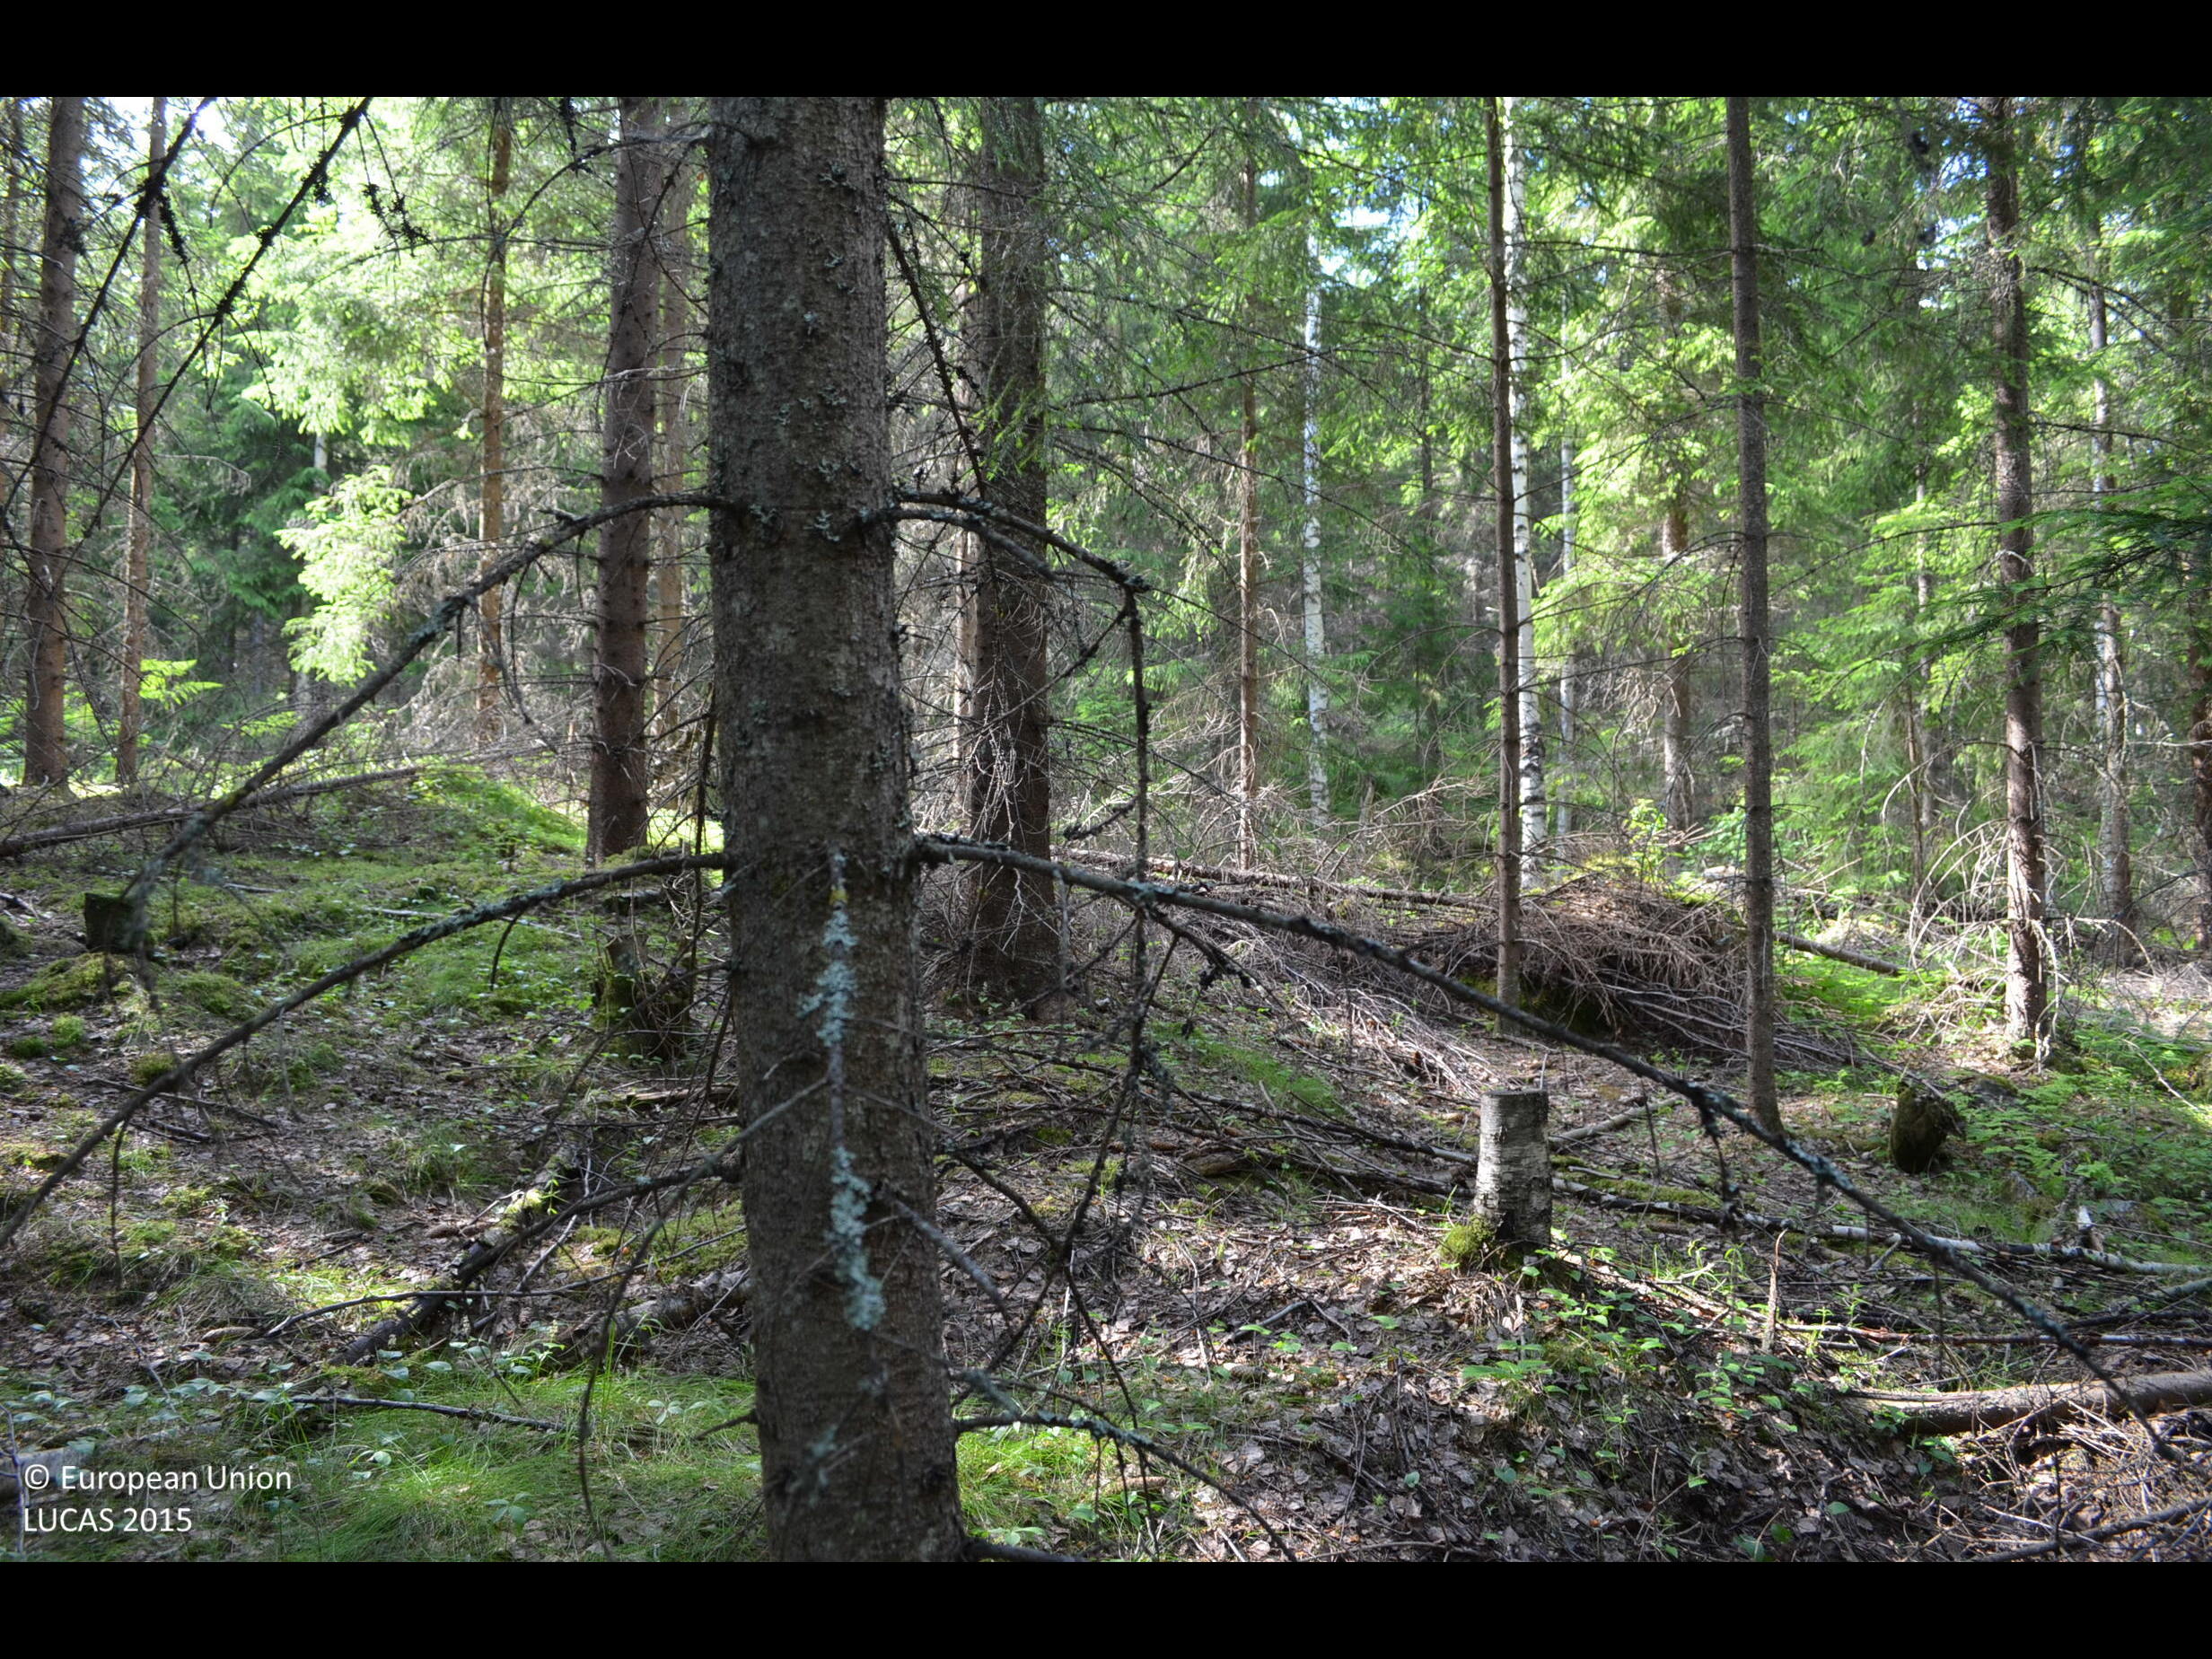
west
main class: Woodland
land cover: Spruce dominated mixed woodland
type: boreal forest
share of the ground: > 75 %
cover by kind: coniferous forest trees 55 %, broadleaved forest trees 20 %, shrubs 10 %, herbaceous plants 5 %, lichens and mosses 5 %
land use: Forestry
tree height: > 5 m
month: July
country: FI
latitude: 61.8388
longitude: 23.4665
